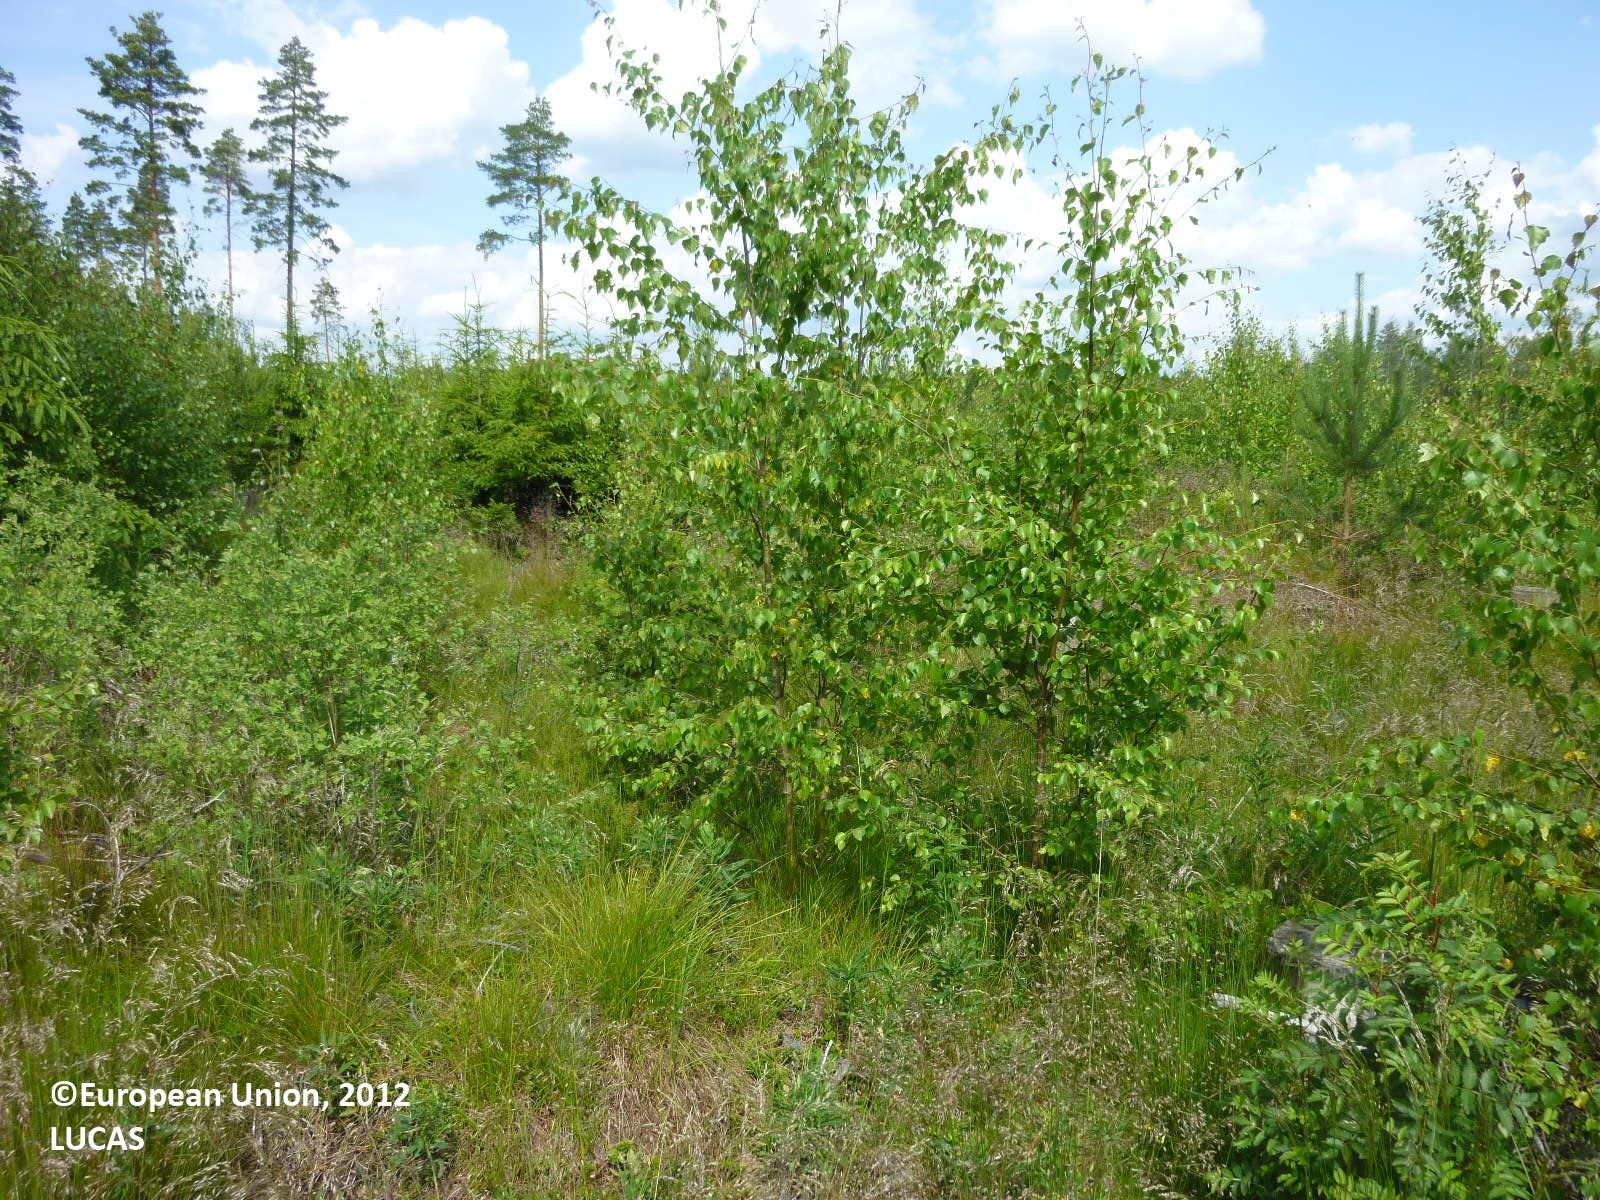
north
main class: Woodland
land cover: Other mixed woodland
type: boreal forest
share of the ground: 50 - 75 %
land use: Forestry
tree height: < 5 m
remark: Clear cut
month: July
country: FI
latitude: 61.2046
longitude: 22.3652
